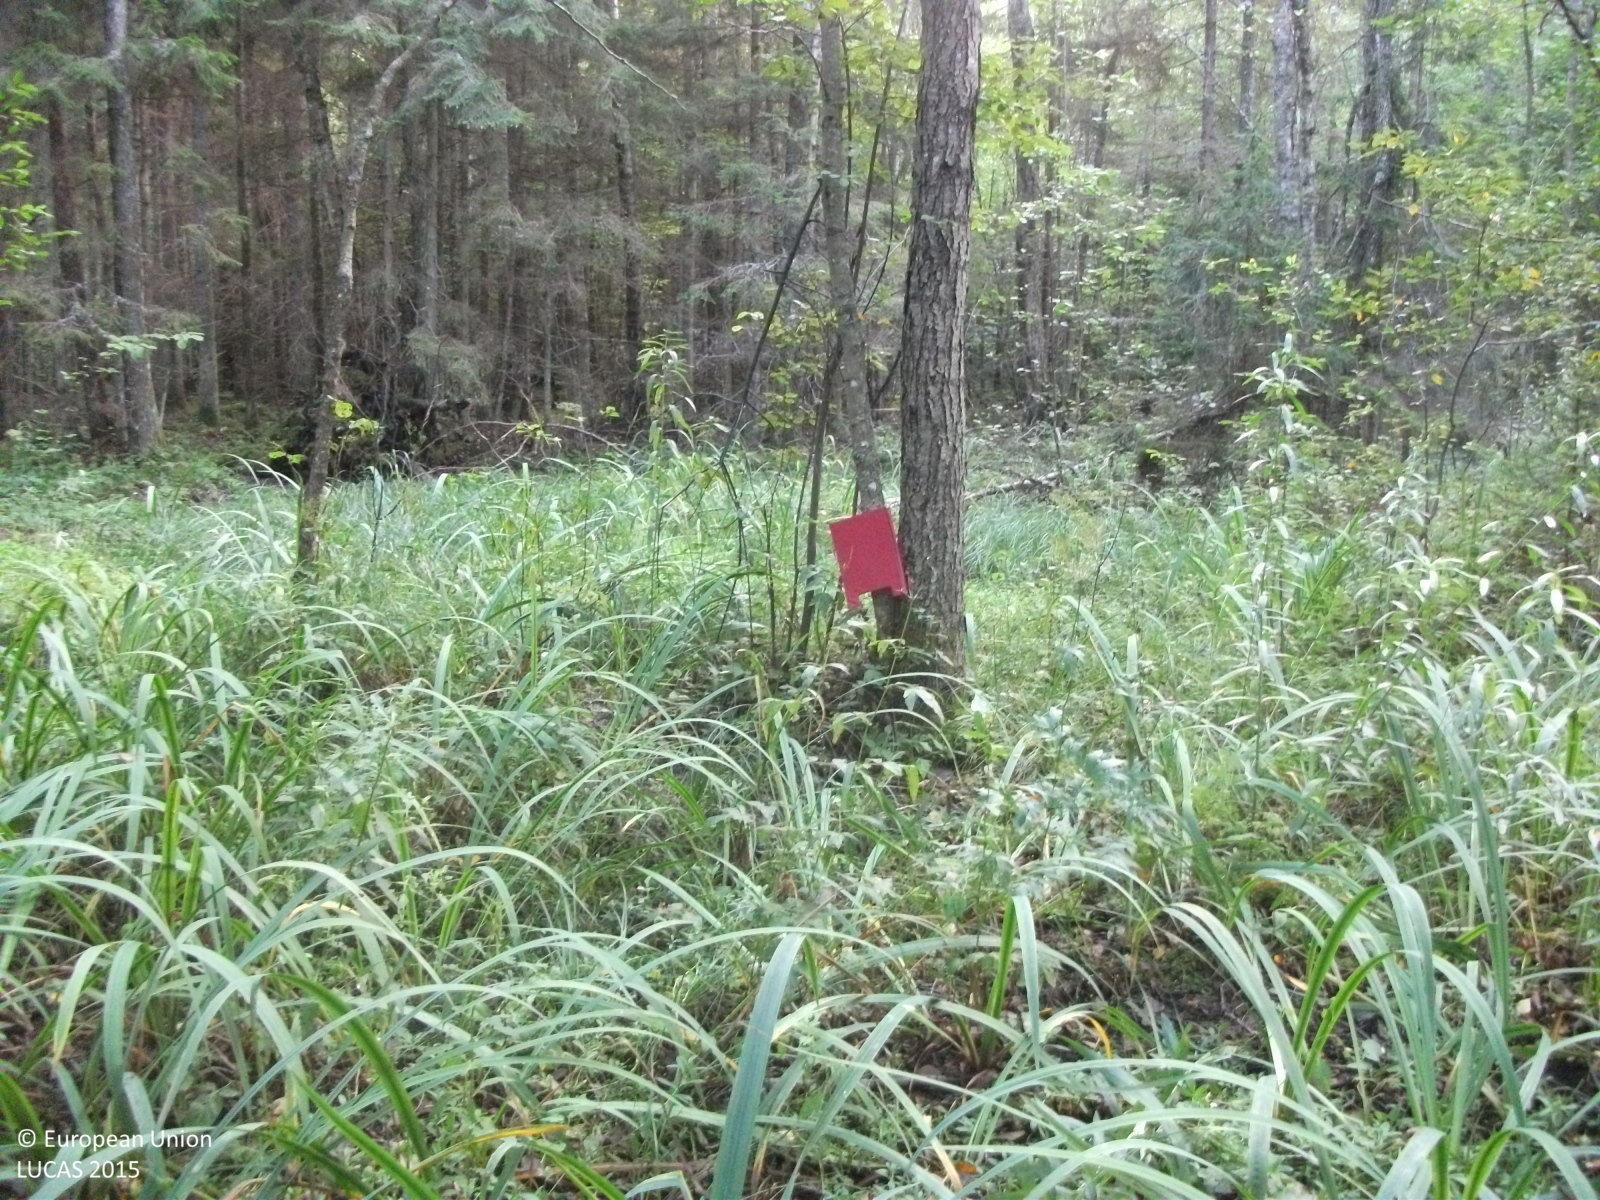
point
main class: Woodland
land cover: Other mixed woodland
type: hemiboreal forest and nemoral coniferous forest and mixed broadleaved-coniferous forest
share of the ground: 50 - 75 %
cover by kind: broadleaved forest trees 50 %, coniferous forest trees 20 %, herbaceous plants 20 %, shrubs 5 %, lichens and mosses 5 %
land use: Forestry
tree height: > 5 m
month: September
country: LV
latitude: 57.5683
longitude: 24.3824
